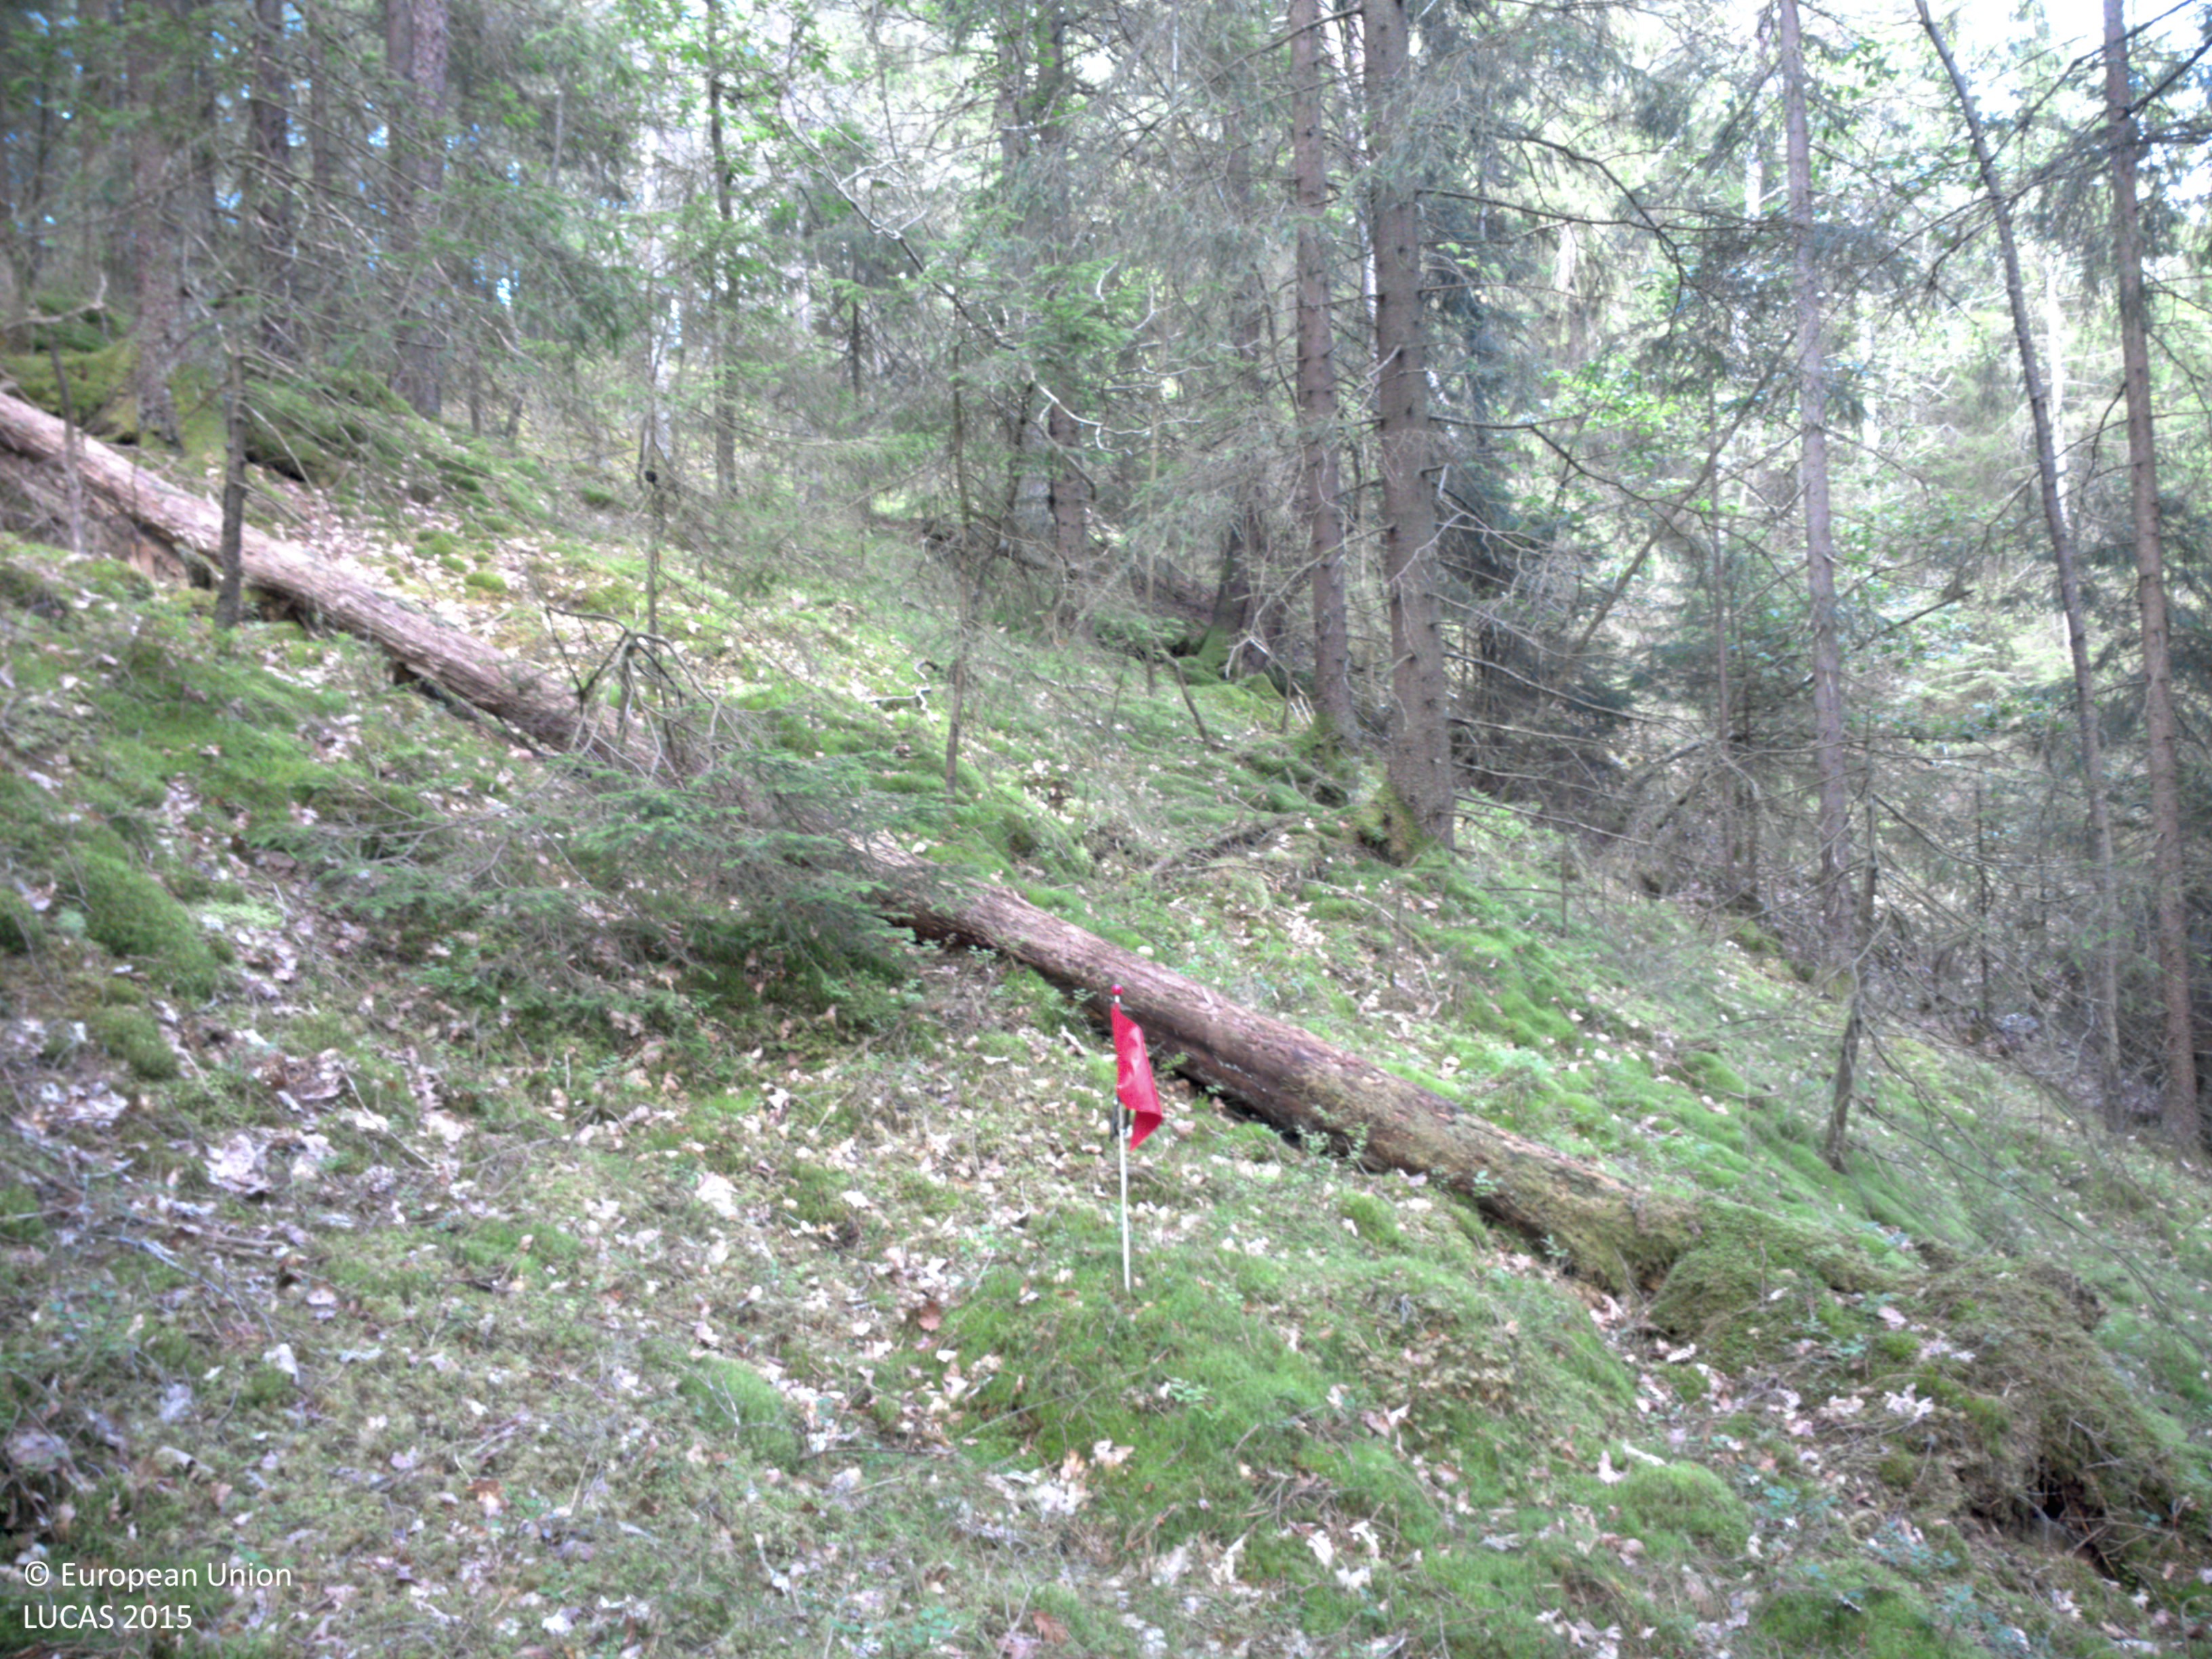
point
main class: Woodland
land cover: Spruce dominated coniferous woodland
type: boreal forest
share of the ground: 50 - 75 %
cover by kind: coniferous forest trees 60 %, herbaceous plants 25 %, shrubs 15 %
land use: Forestry
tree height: > 5 m
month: August
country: SE
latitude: 58.0430
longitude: 11.9783
